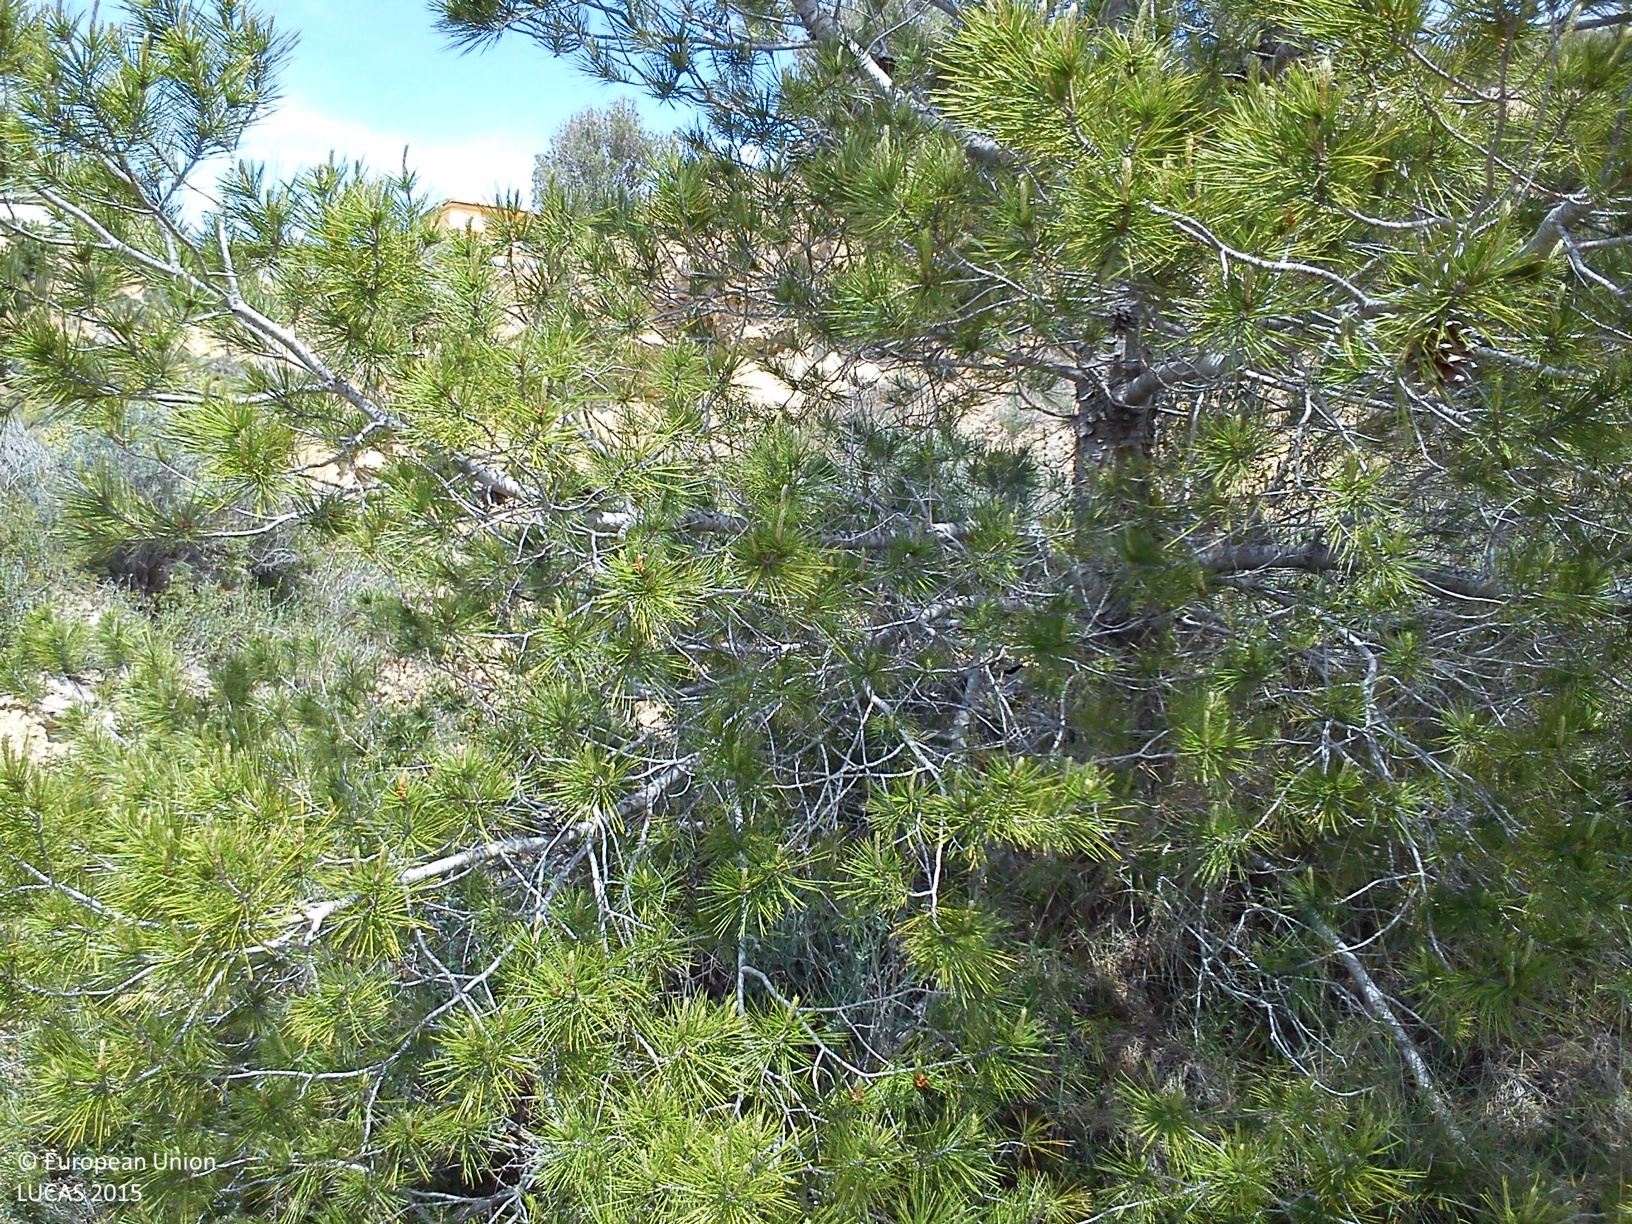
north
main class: Shrubland
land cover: Shrubland with sparse tree cover
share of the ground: > 75 %
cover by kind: shrubs 70 %, herbaceous plants 15 %, consolidated bare surface 10 %, coniferous forest trees 5 %
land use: Semi-natural and natural areas not in use
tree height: < 5 m
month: April
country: ES
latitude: 39.3613
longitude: -0.6166
